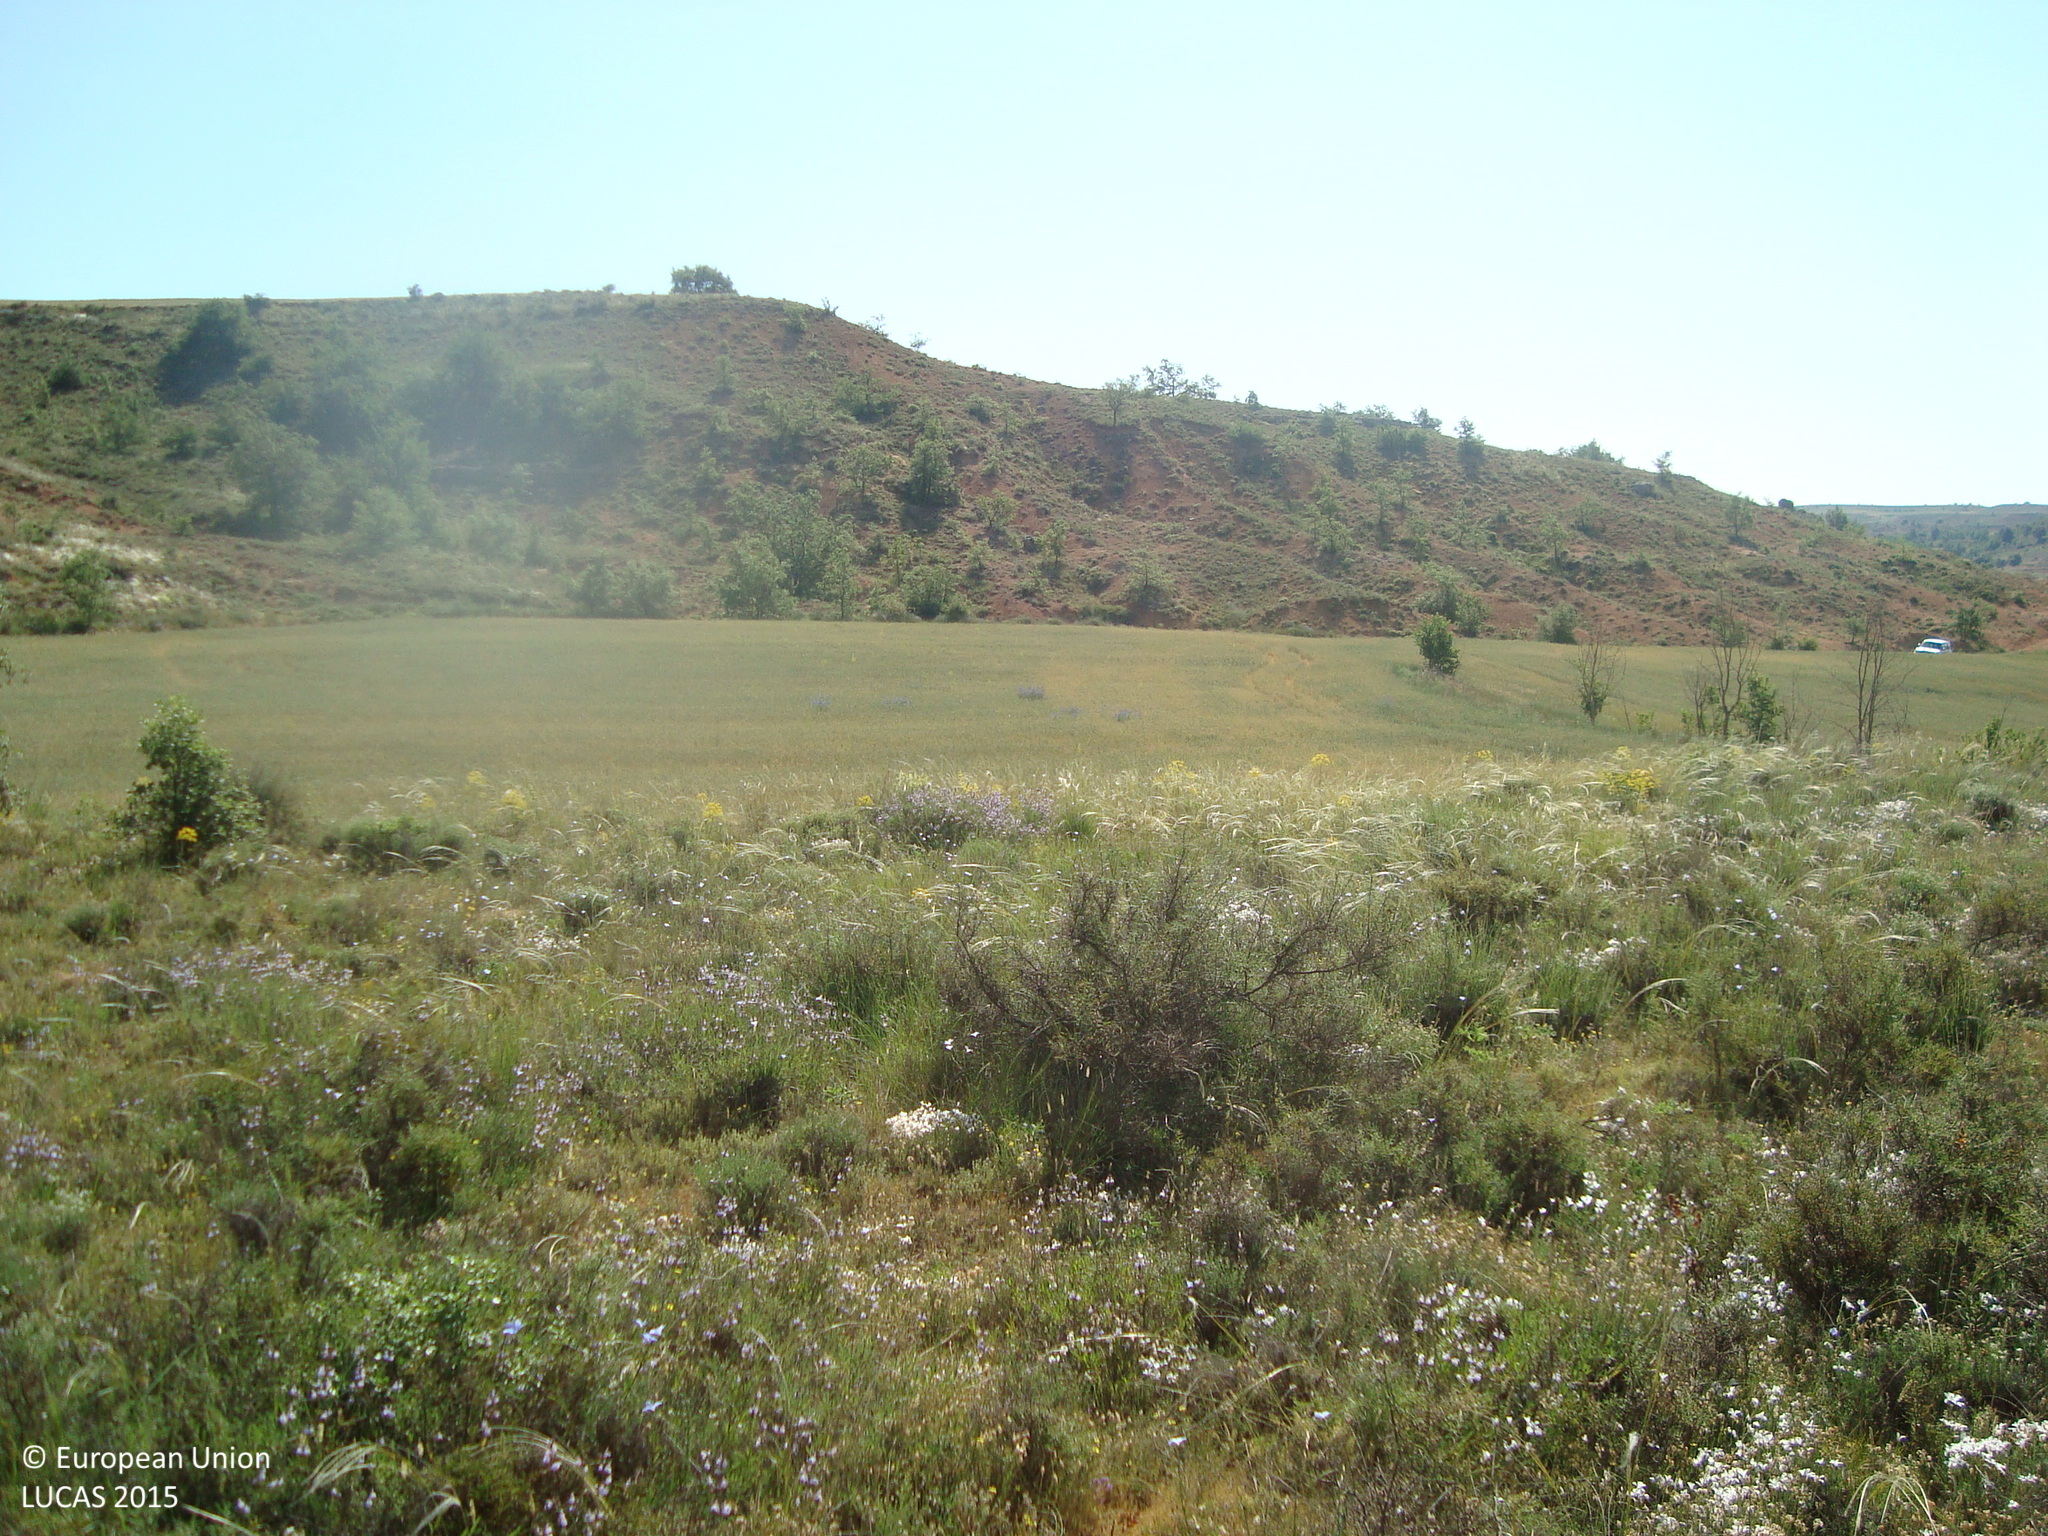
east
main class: Shrubland
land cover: Shrubland with sparse tree cover
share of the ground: > 75 %
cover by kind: shrubs 75 %, herbaceous plants 15 %, broadleaved forest trees 5 %, unconsolidated bare surface 5 %
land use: Semi-natural and natural areas not in use
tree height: < 5 m
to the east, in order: Shrubland with sparse tree cover; Spontaneously vegetated surfaces; Rivers and streams; Grass margins; Common wheat; Rivers and streams; Shrubland with sparse tree cover
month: June
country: ES
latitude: 41.7784
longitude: -3.6608
